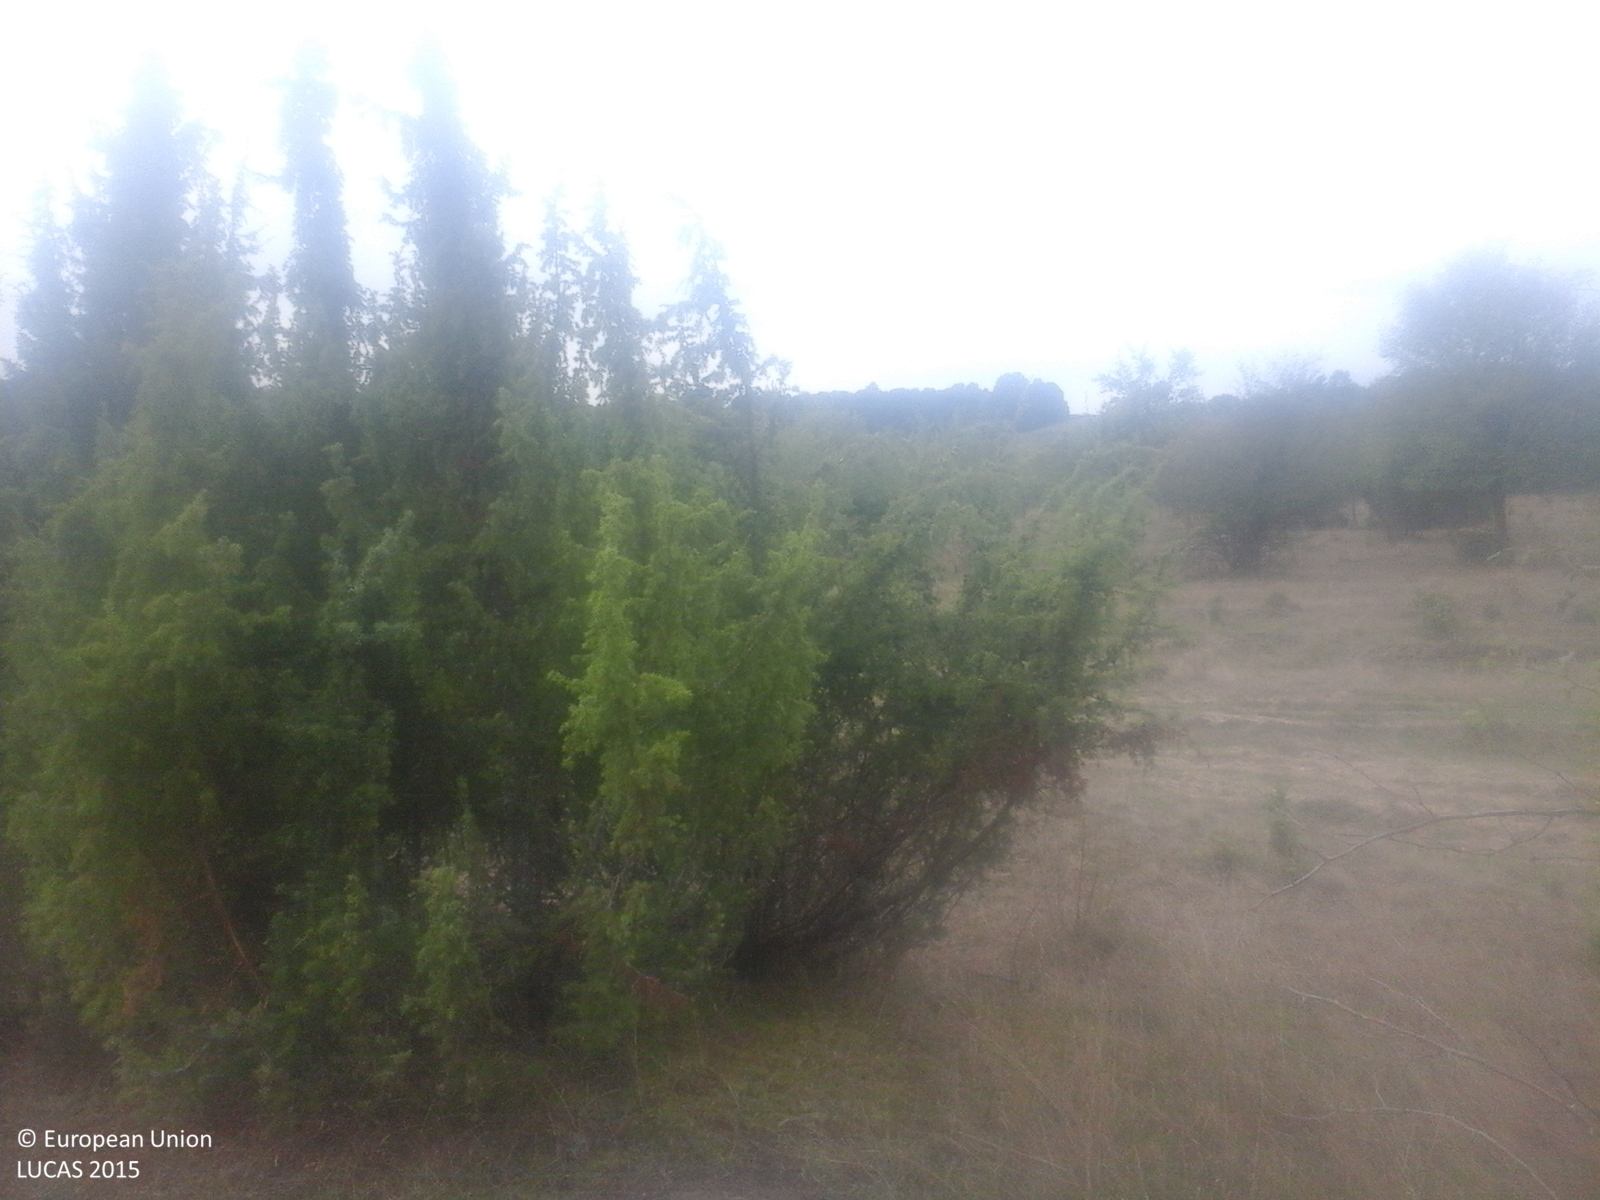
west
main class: Shrubland
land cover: Shrubland with sparse tree cover
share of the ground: > 75 %
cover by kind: shrubs 60 %, herbaceous plants 35 %, coniferous forest trees 5 %
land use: Forestry
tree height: < 5 m
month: September
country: RO
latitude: 45.4254
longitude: 21.9361
